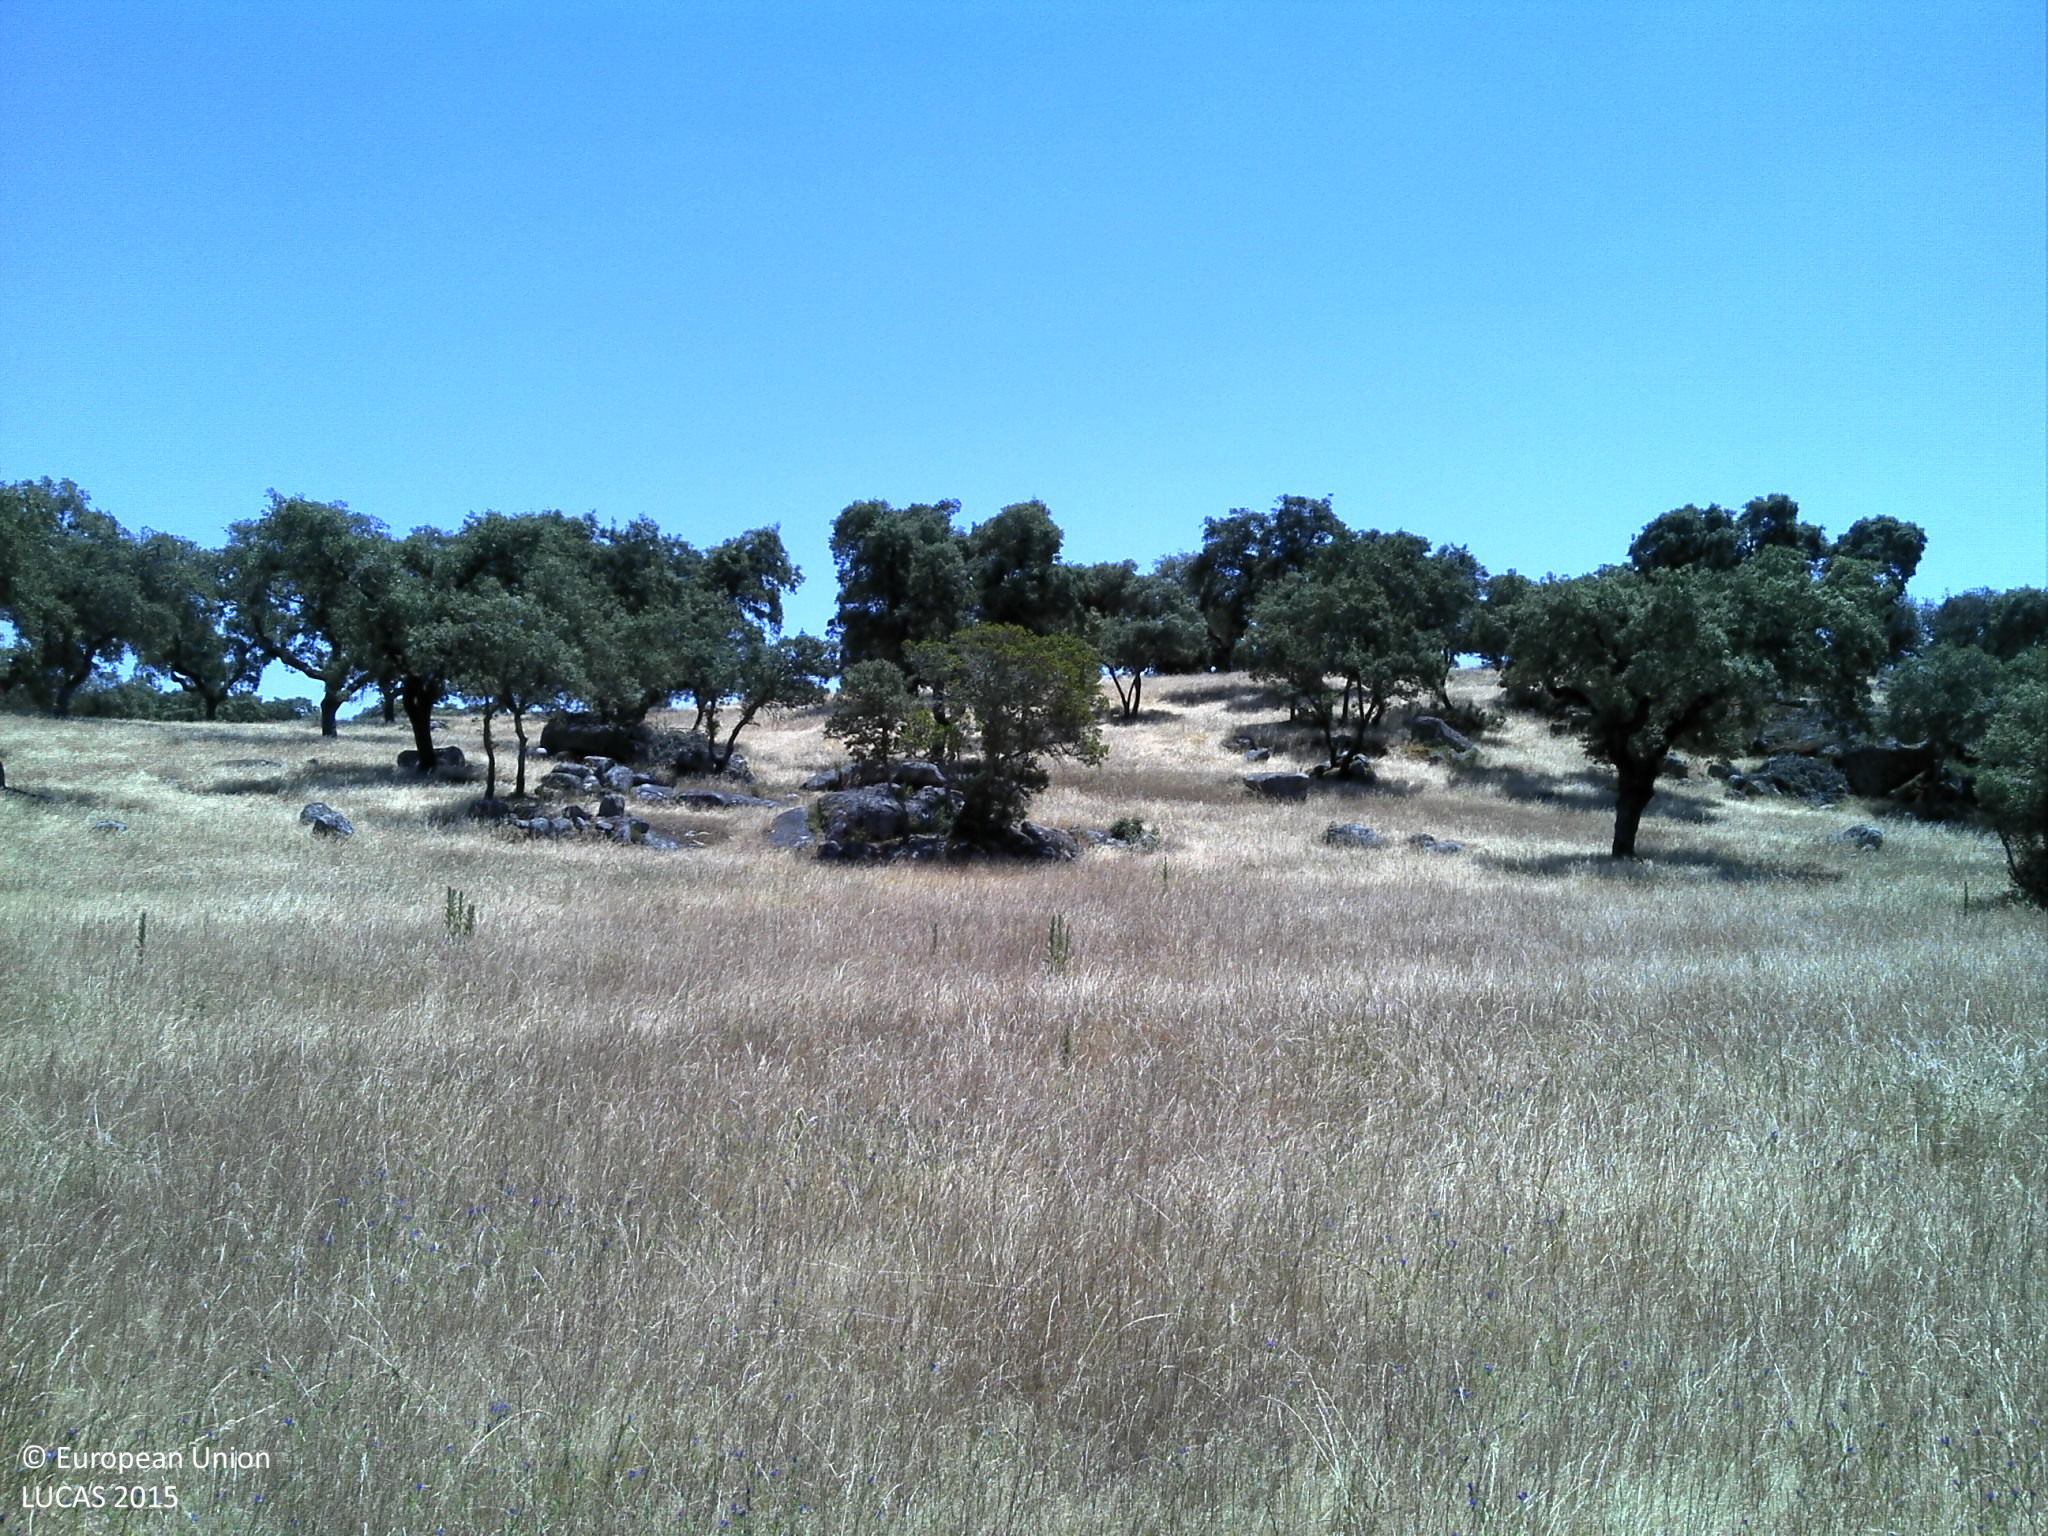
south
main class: Grassland
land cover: Grassland without tree/shrub cover
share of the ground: > 75 %
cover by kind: herbaceous plants 90 %, unconsolidated bare surface 10 %
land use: Agriculture (excluding fallow land and kitchen gardens)
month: May
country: PT
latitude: 38.8094
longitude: -8.0940
